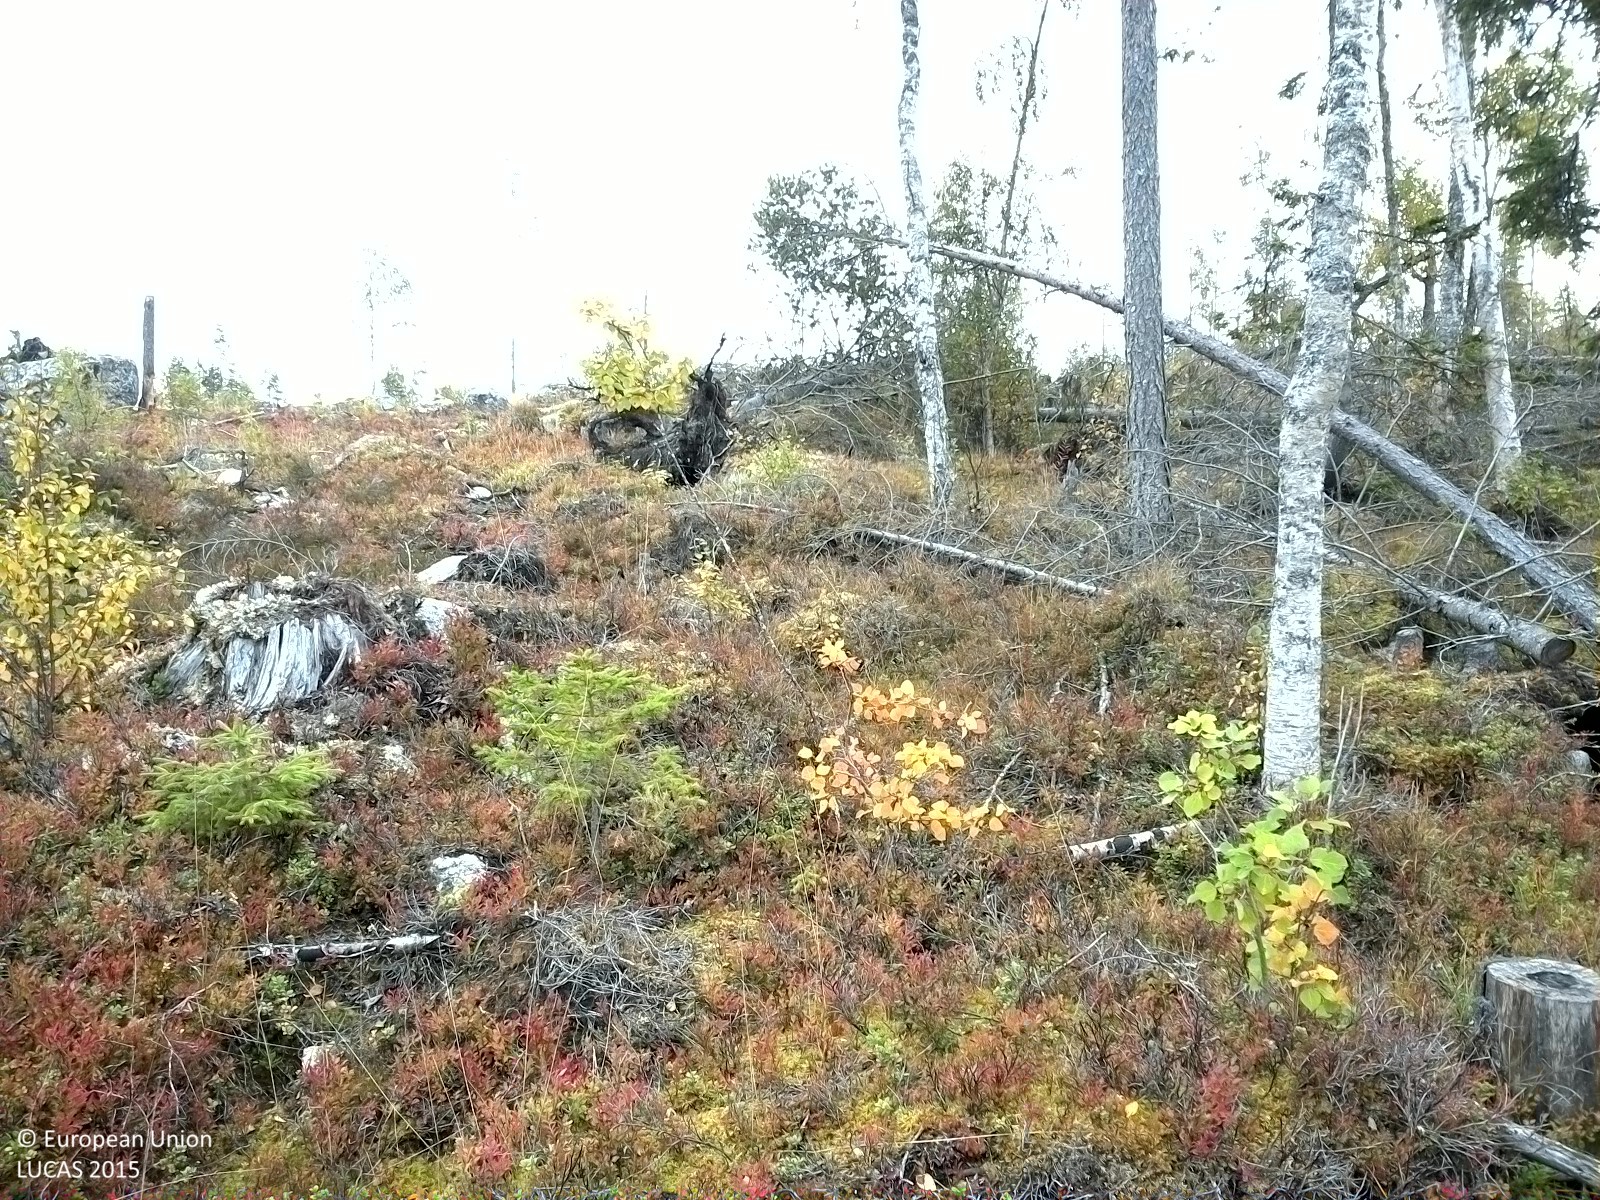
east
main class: Woodland
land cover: Spruce dominated mixed woodland
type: boreal forest
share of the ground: 10 - 25 %
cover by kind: shrubs 50 %, herbaceous plants 20 %, coniferous forest trees 10 %, broadleaved forest trees 10 %, lichens and mosses 10 %
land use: Forestry
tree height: < 5 m
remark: Clear cut
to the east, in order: Spruce dominated mixed woodland; Other mixed woodland; Shrubland with sparse tree cover; Other mixed woodland
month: September
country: SE
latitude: 62.2378
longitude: 15.5808
